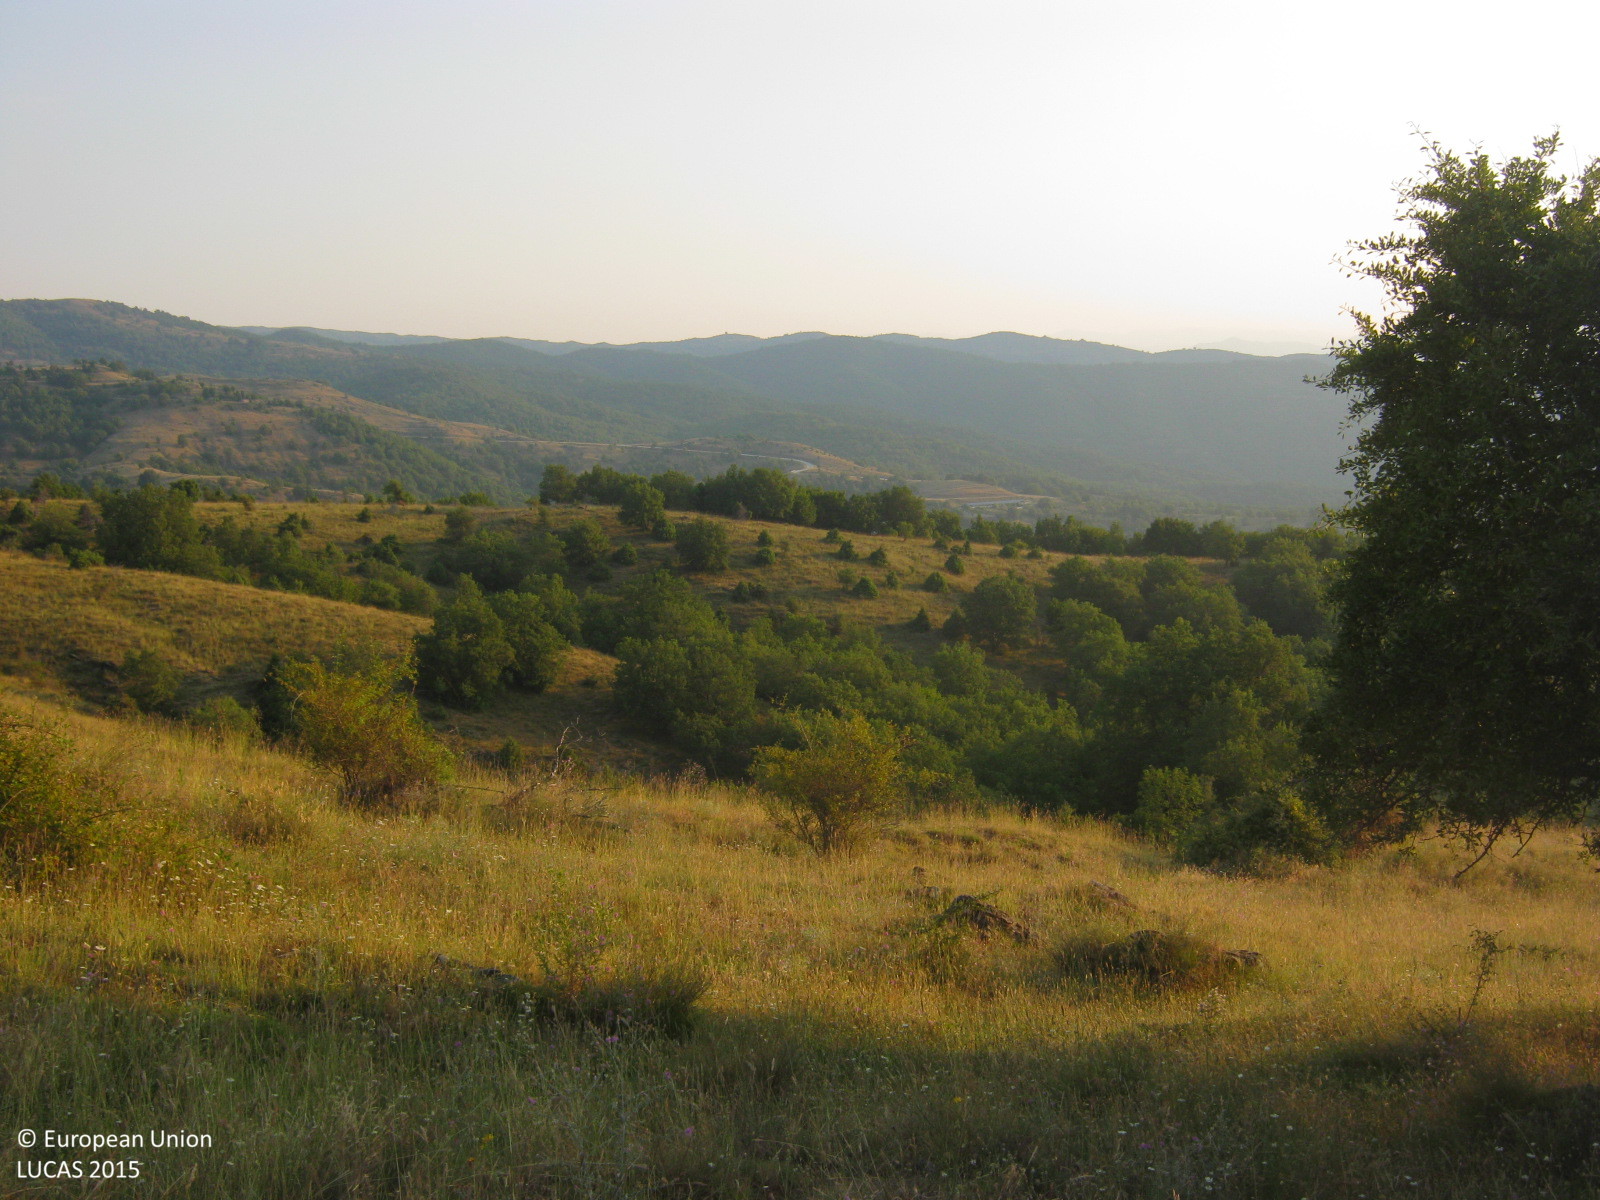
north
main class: Grassland
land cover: Grassland with sparse tree/shrub cover
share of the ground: > 75 %
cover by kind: herbaceous plants 85 %, shrubs 10 %, broadleaved forest trees 5 %
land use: Agriculture (excluding fallow land and kitchen gardens)
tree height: < 5 m
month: July
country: GR
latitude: 41.2680
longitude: 24.4193
